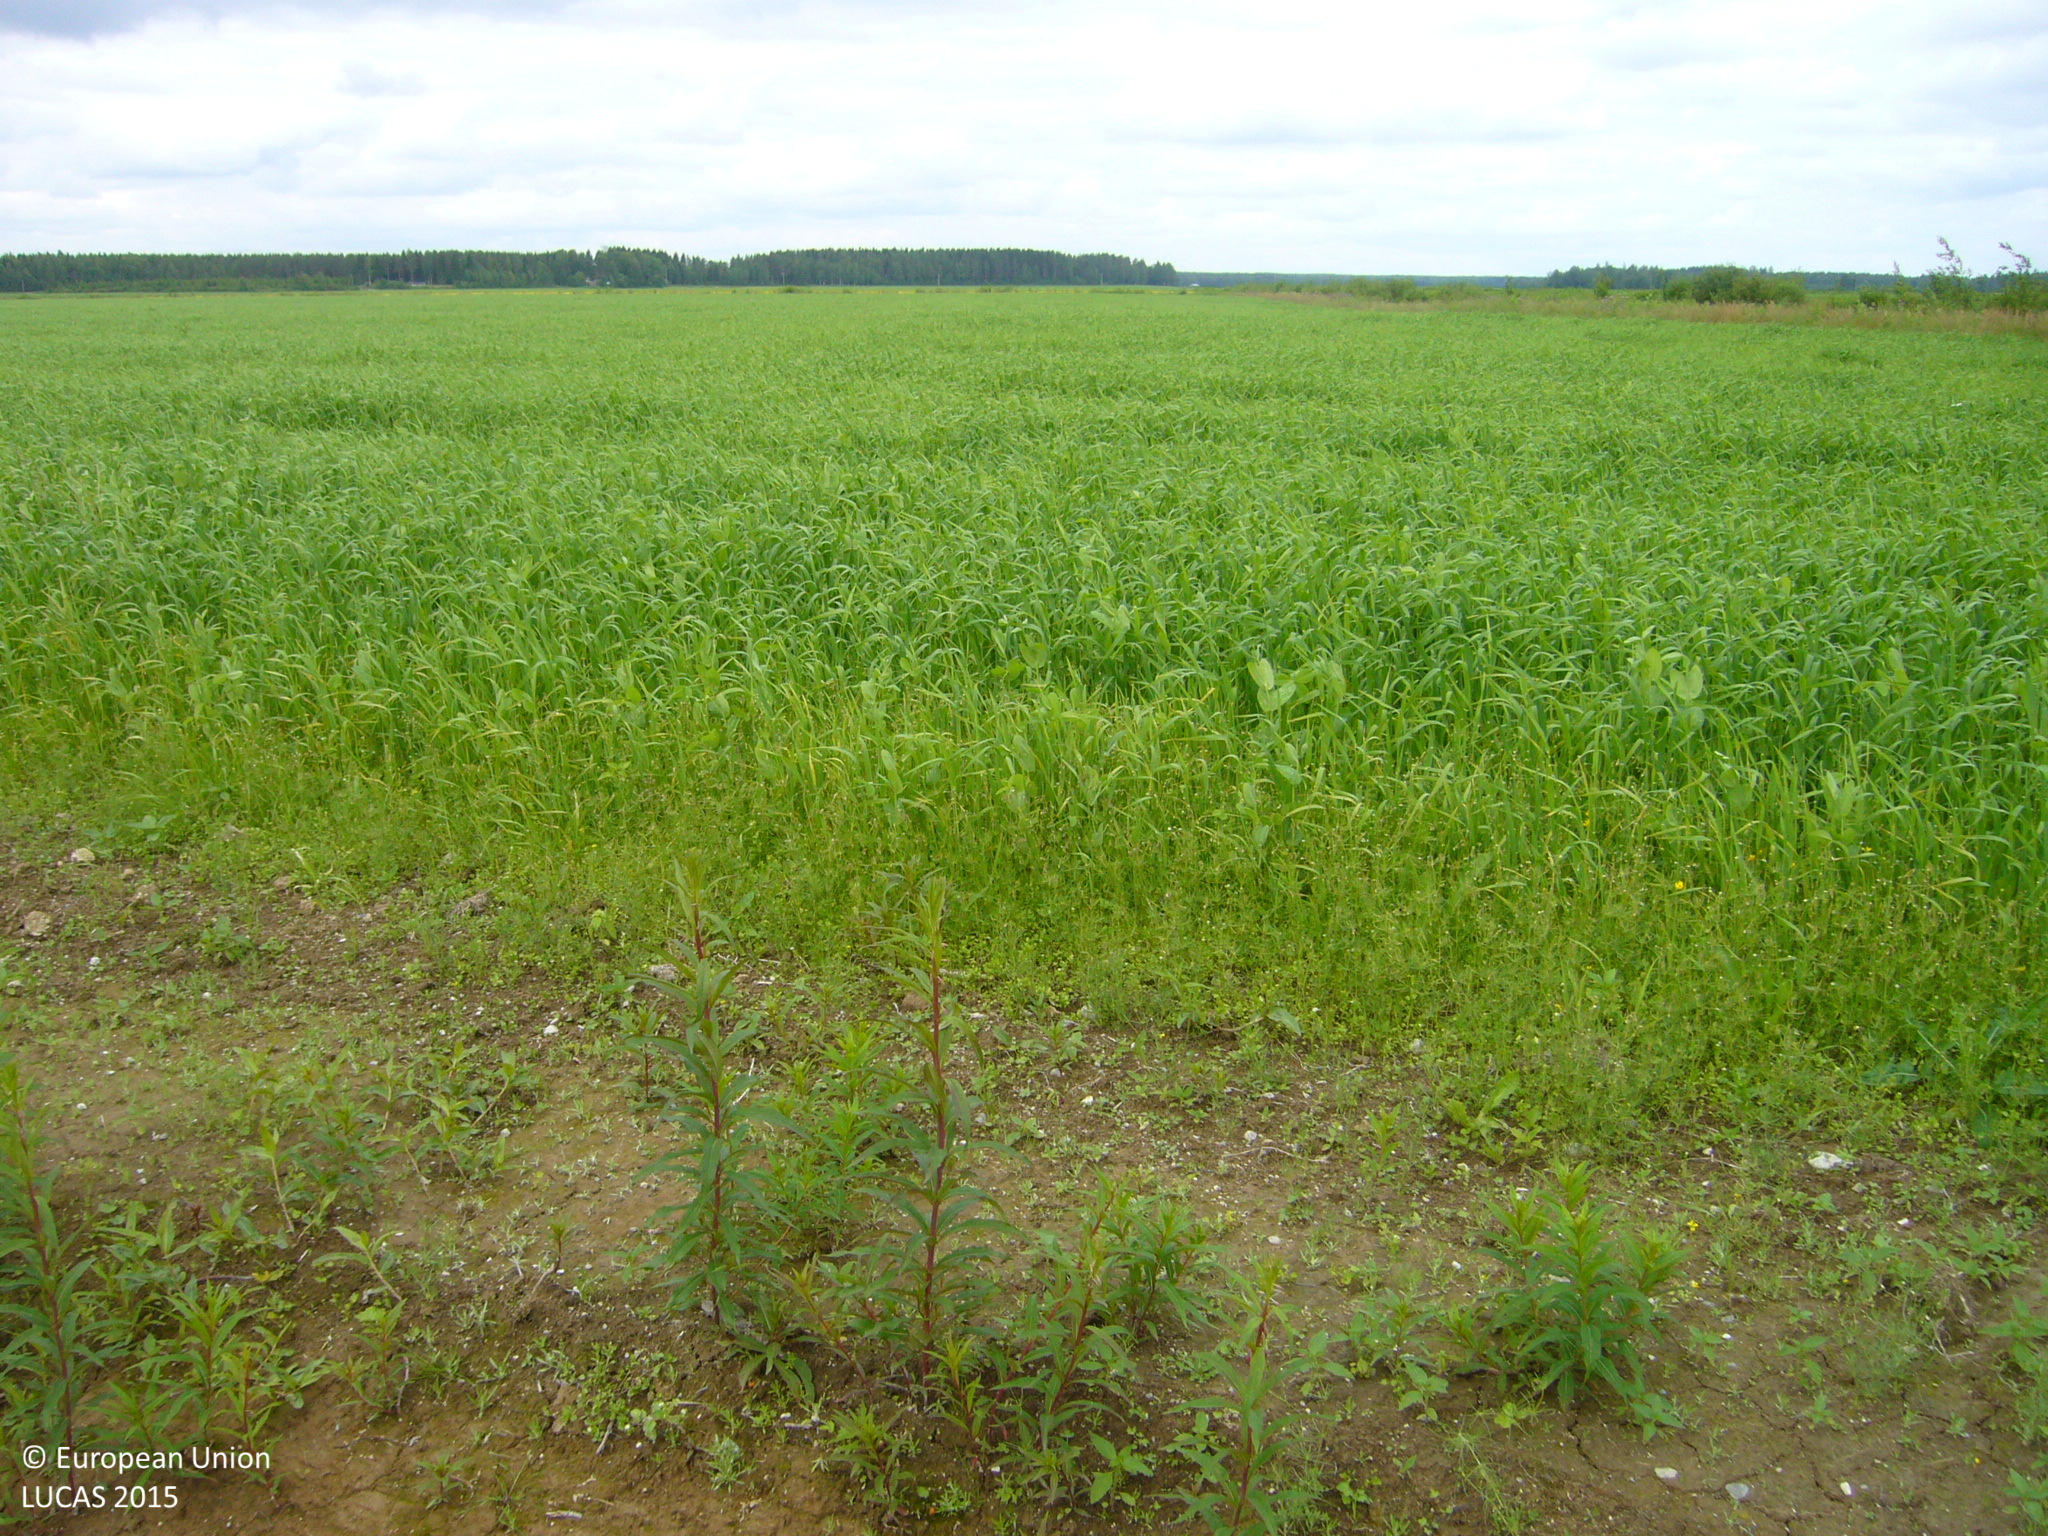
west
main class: Cropland
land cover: Barley
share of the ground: > 75 %
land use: Agriculture (excluding fallow land and kitchen gardens)
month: July
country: FI
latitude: 63.6867
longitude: 25.1140
